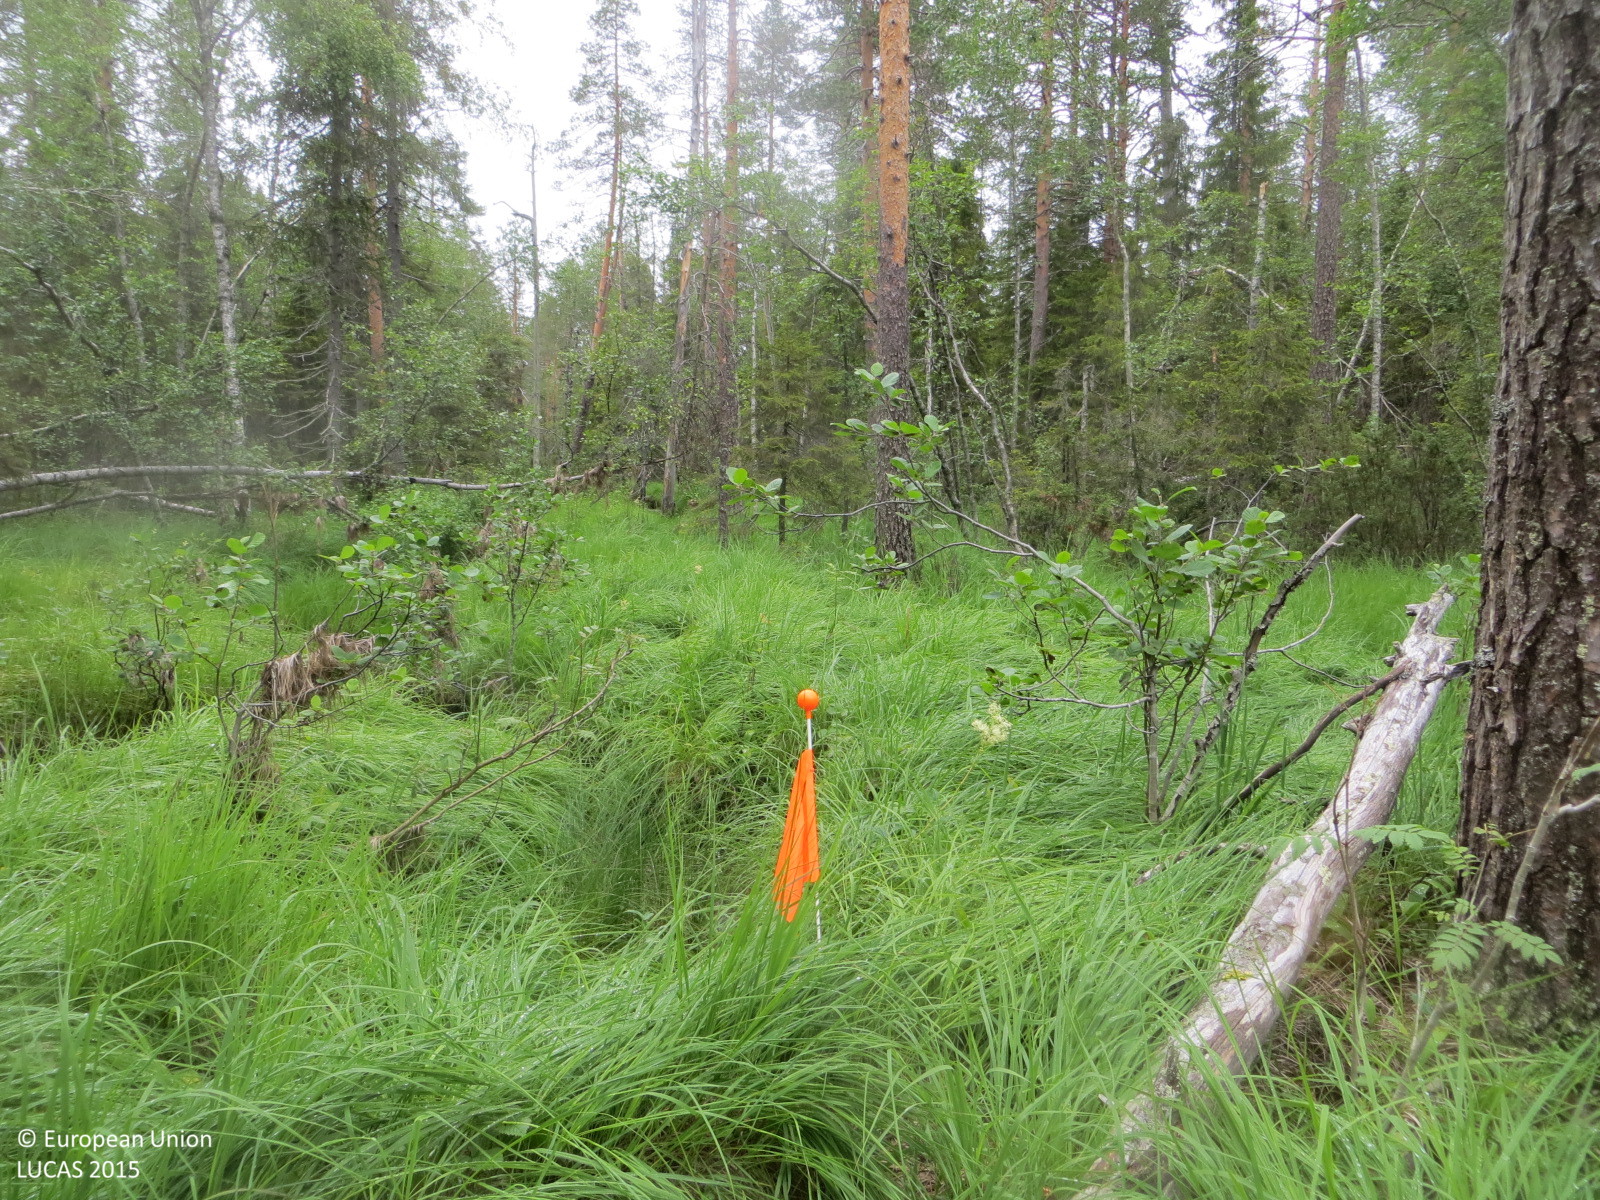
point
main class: Woodland
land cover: Other mixed woodland
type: boreal forest
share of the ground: 50 - 75 %
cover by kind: herbaceous plants 45 %, coniferous forest trees 30 %, broadleaved forest trees 25 %
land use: Semi-natural and natural areas not in use
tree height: > 5 m
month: July
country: FI
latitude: 66.2999
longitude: 24.8352
